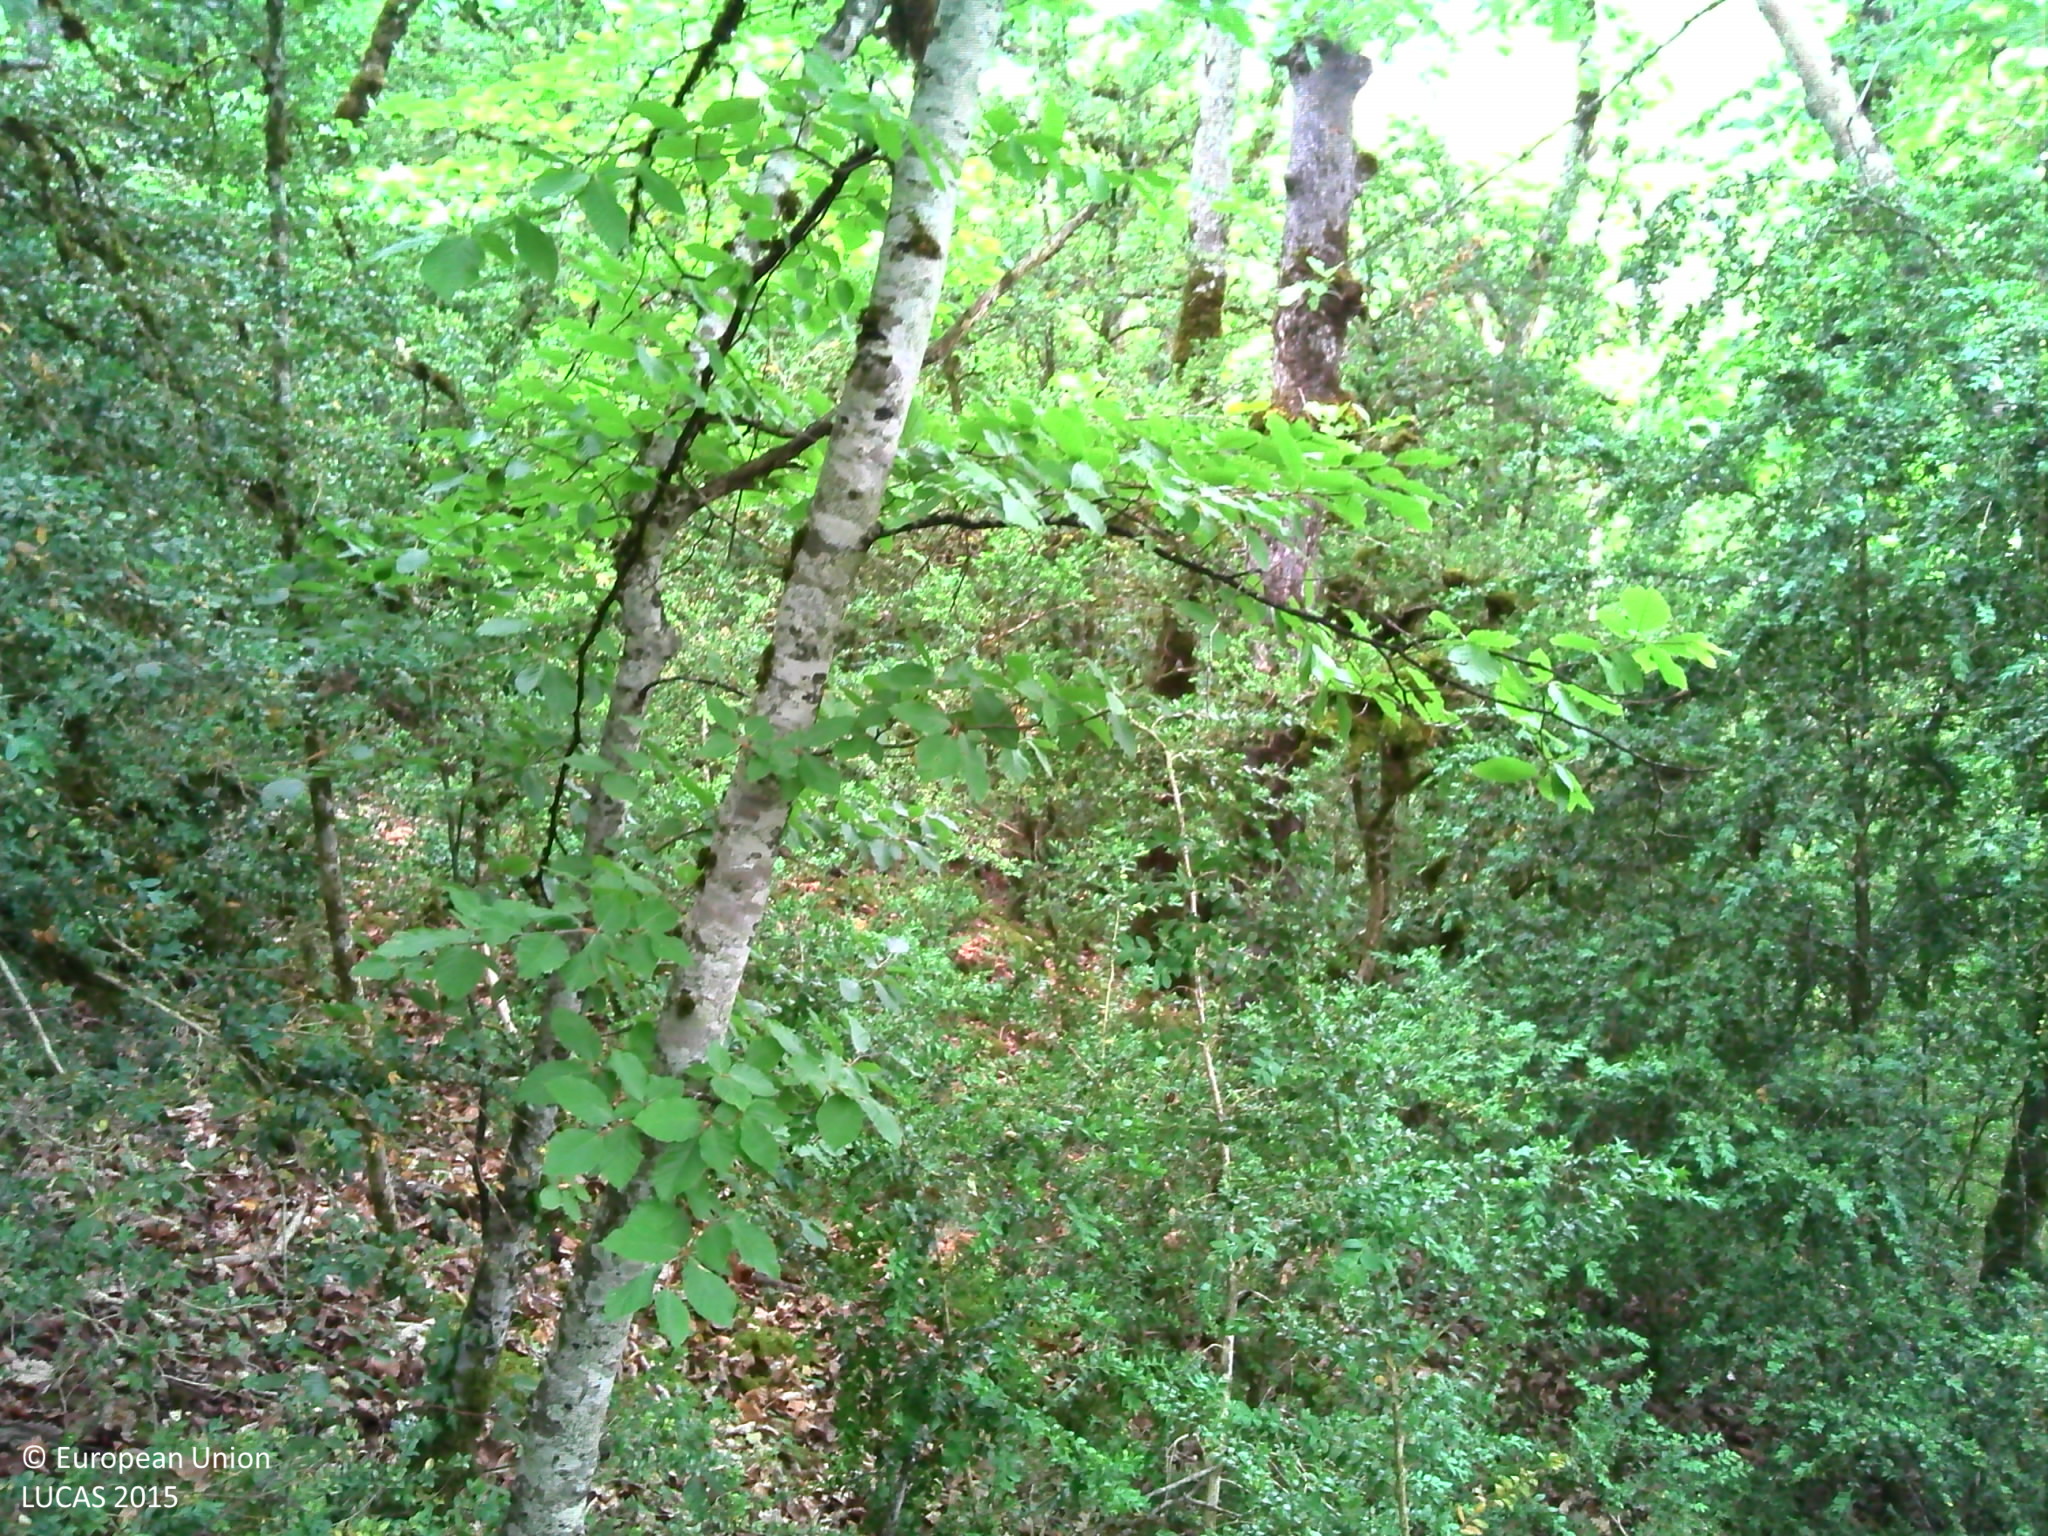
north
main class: Woodland
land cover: Broadleaved woodland
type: acidophilous oak and oak-birch forest
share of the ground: > 75 %
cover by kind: broadleaved forest trees 80 %, shrubs 10 %, herbaceous plants 5 %, lichens and mosses 5 %
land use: Forestry
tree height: > 5 m
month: July
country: FR
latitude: 44.4189
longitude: 2.9583
